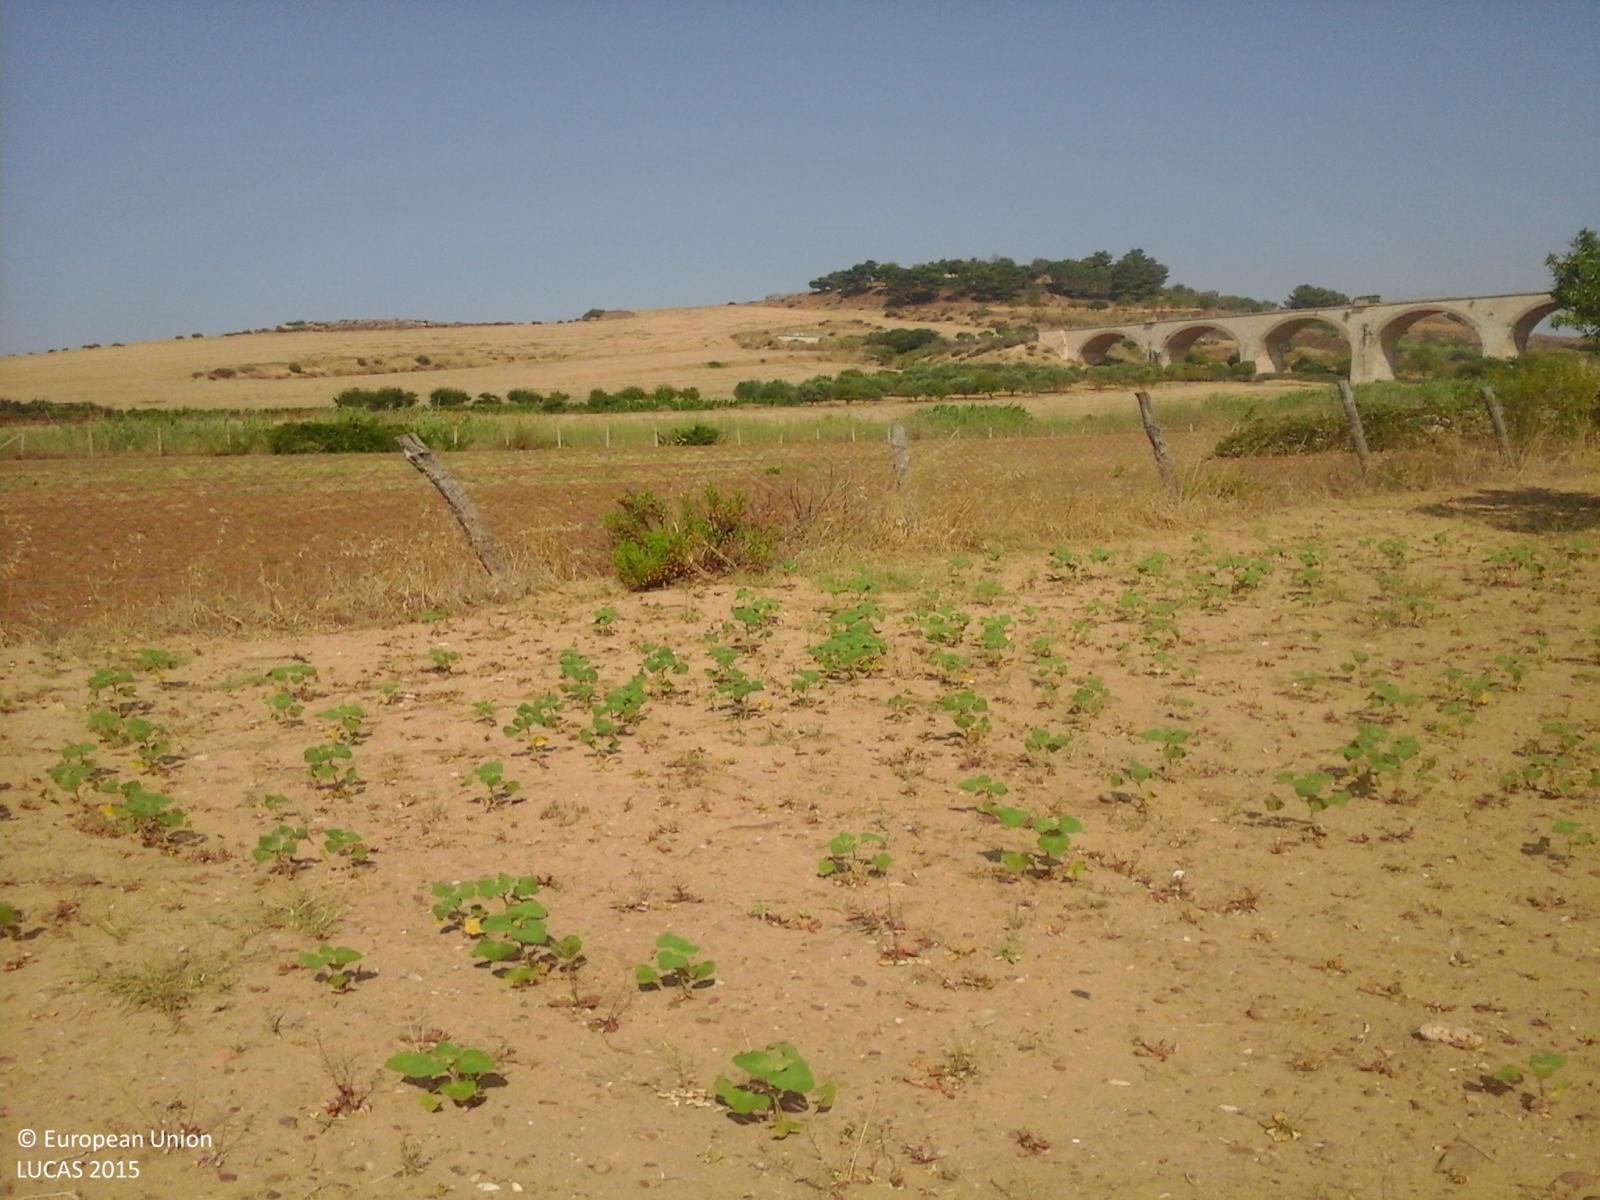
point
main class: Cropland
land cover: Durum wheat
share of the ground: > 75 %
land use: Agriculture (excluding fallow land and kitchen gardens)
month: July
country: IT
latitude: 37.0666
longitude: 14.3408
